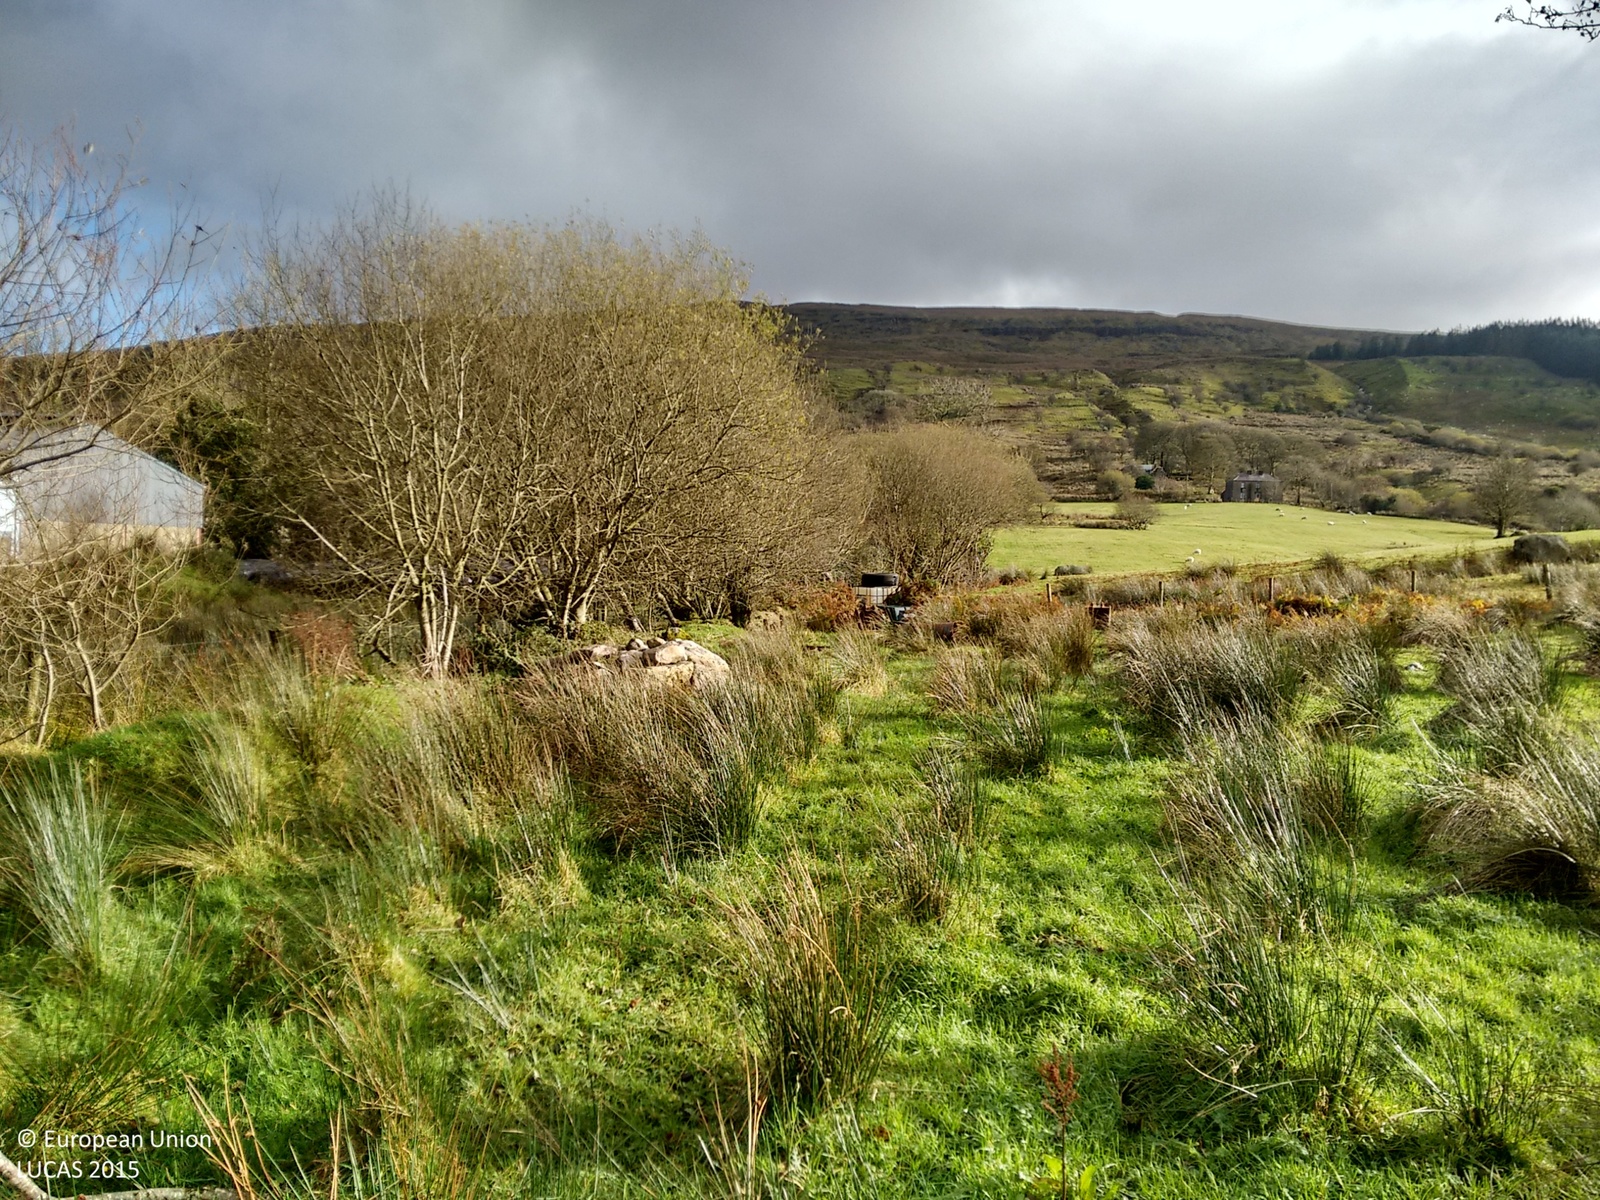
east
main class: Grassland
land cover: Grassland without tree/shrub cover
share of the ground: > 75 %
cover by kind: herbaceous plants 100 %
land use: Agriculture (excluding fallow land and kitchen gardens)
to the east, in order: Grassland without tree/shrub cover; Fences; Grassland without tree/shrub cover; Lines of trees; Rock outcrops; Grassland without tree/shrub cover; Grassland with sparse tree/shrub cover; Dry stone walls; Fences; Abandoned hedges; Grassland without tree/shrub cover
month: November
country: IE
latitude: 54.1006
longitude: -8.0211
